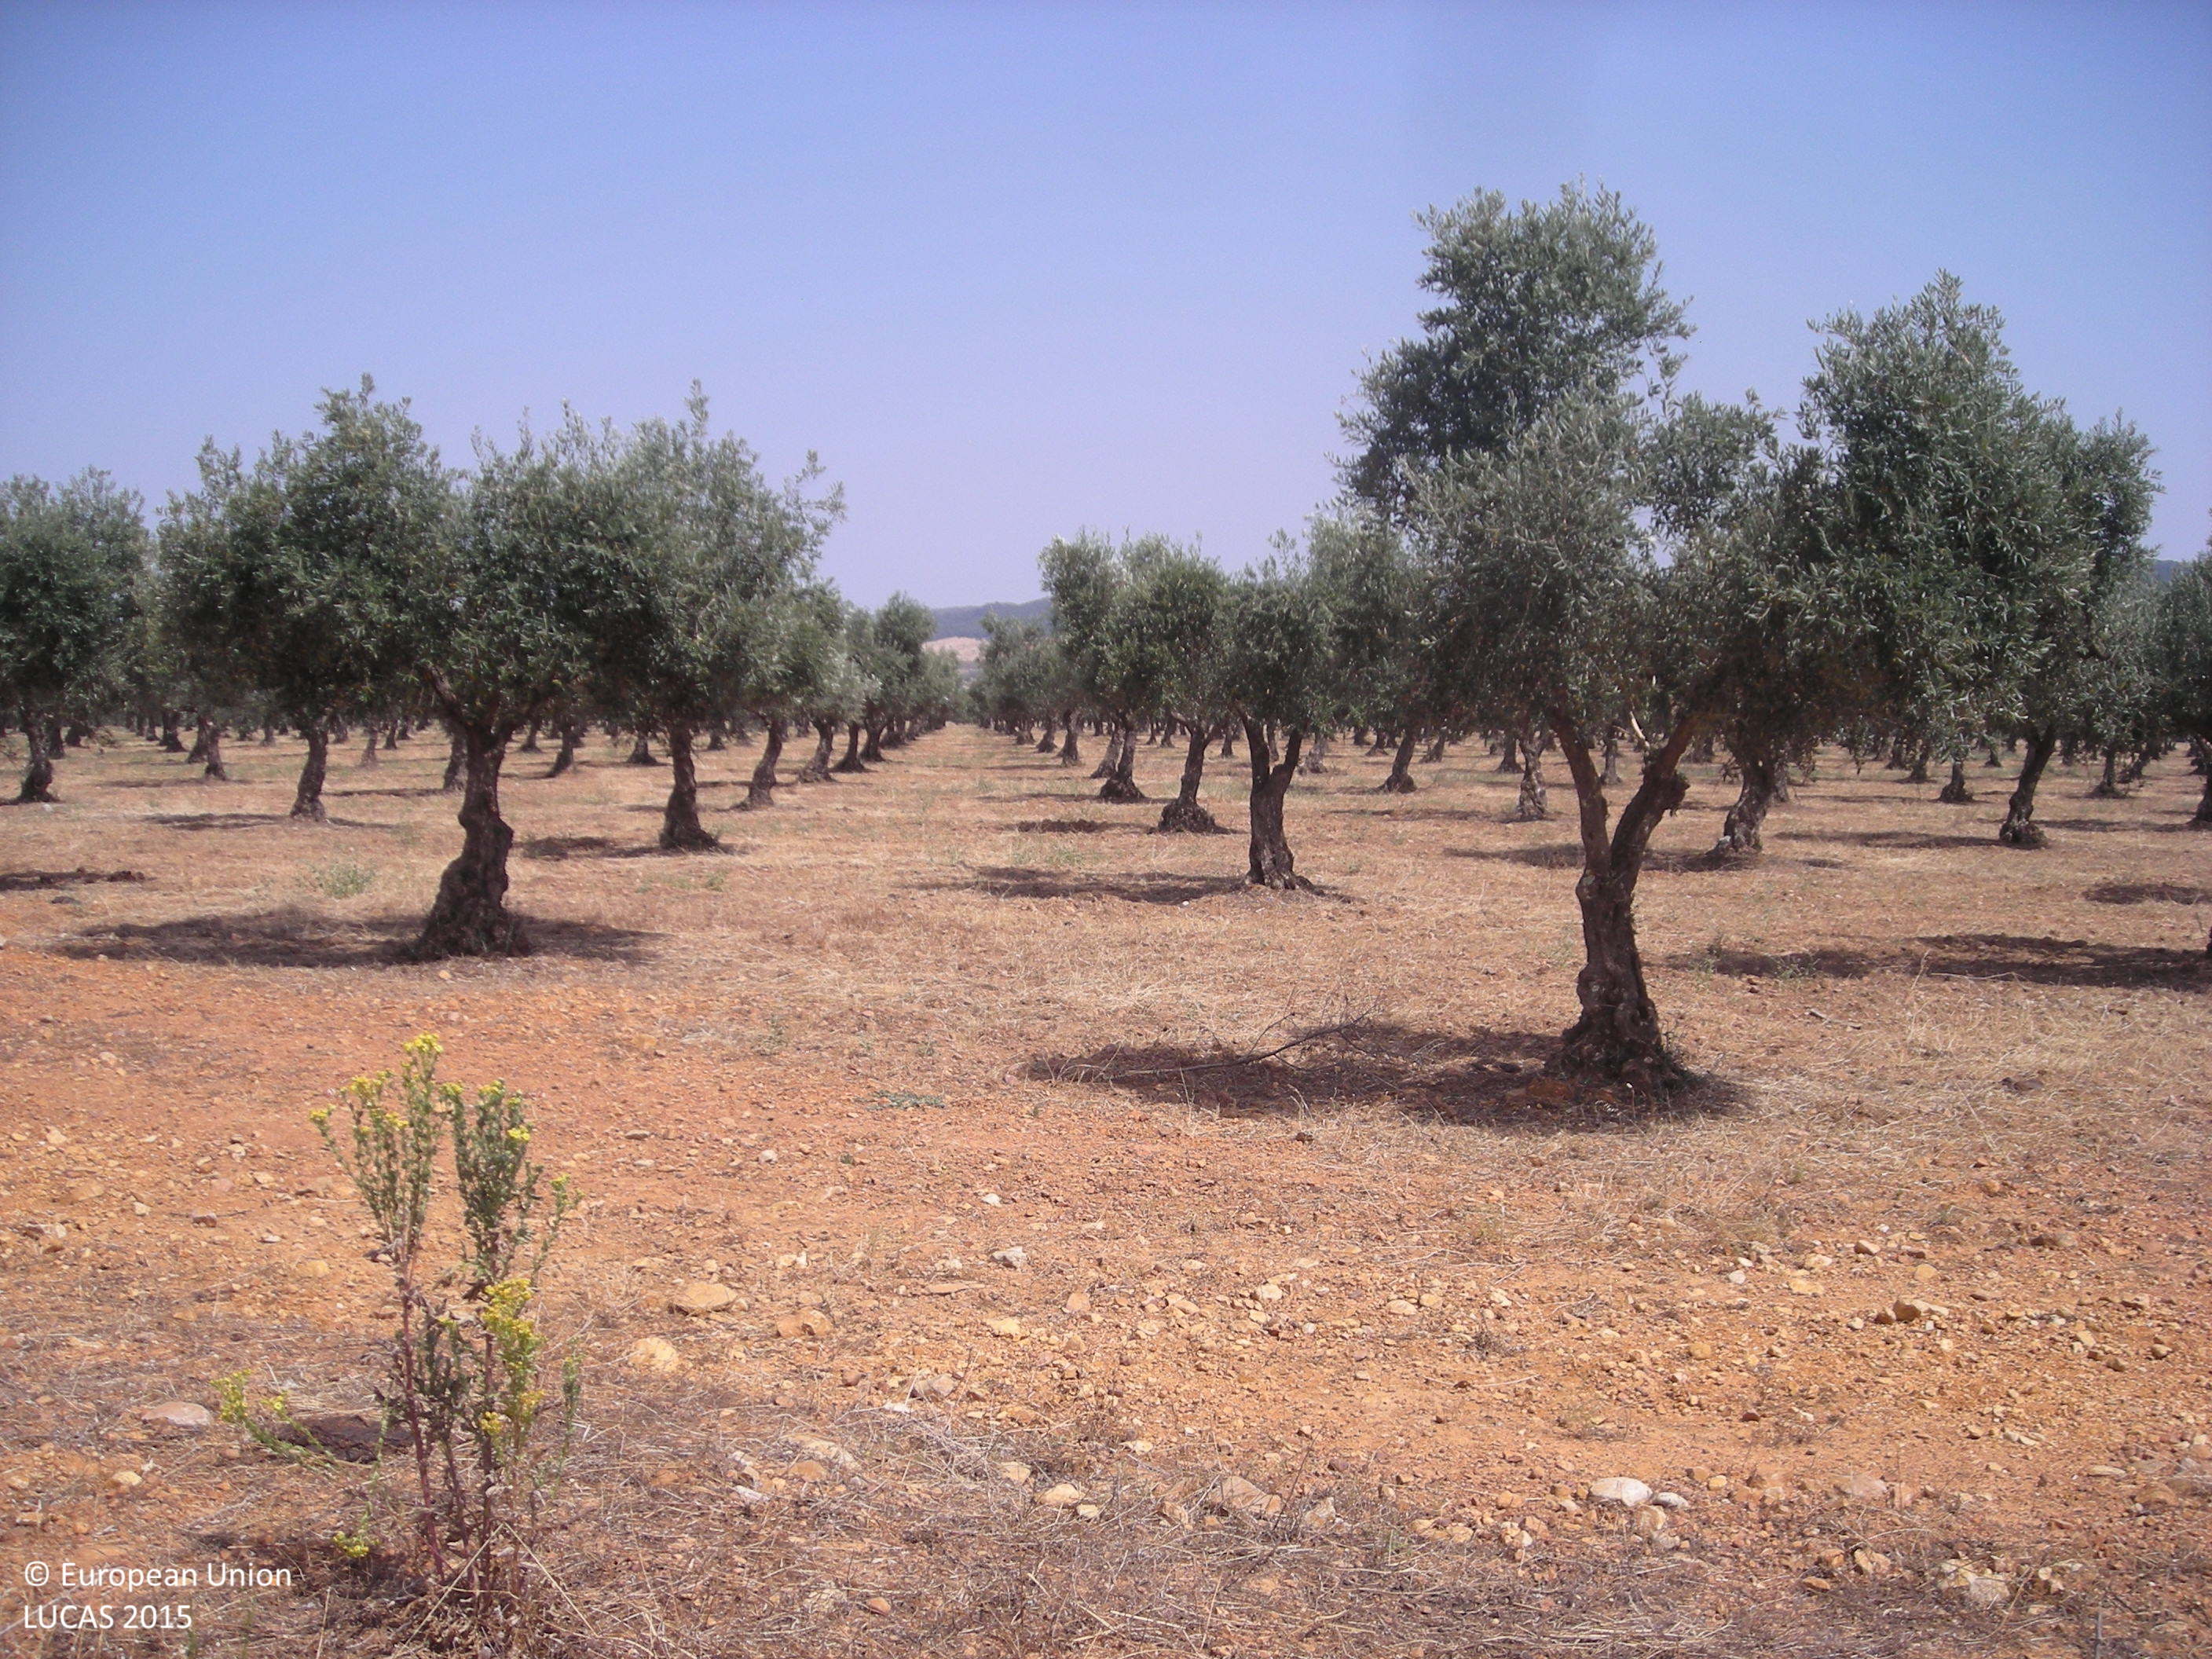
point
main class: Cropland
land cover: Olive groves
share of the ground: 25 - 50 %
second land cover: Grassland without tree/shrub cover
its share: 25 - 50 %
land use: Agriculture (excluding fallow land and kitchen gardens)
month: July
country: ES
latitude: 39.2212
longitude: -5.3221
